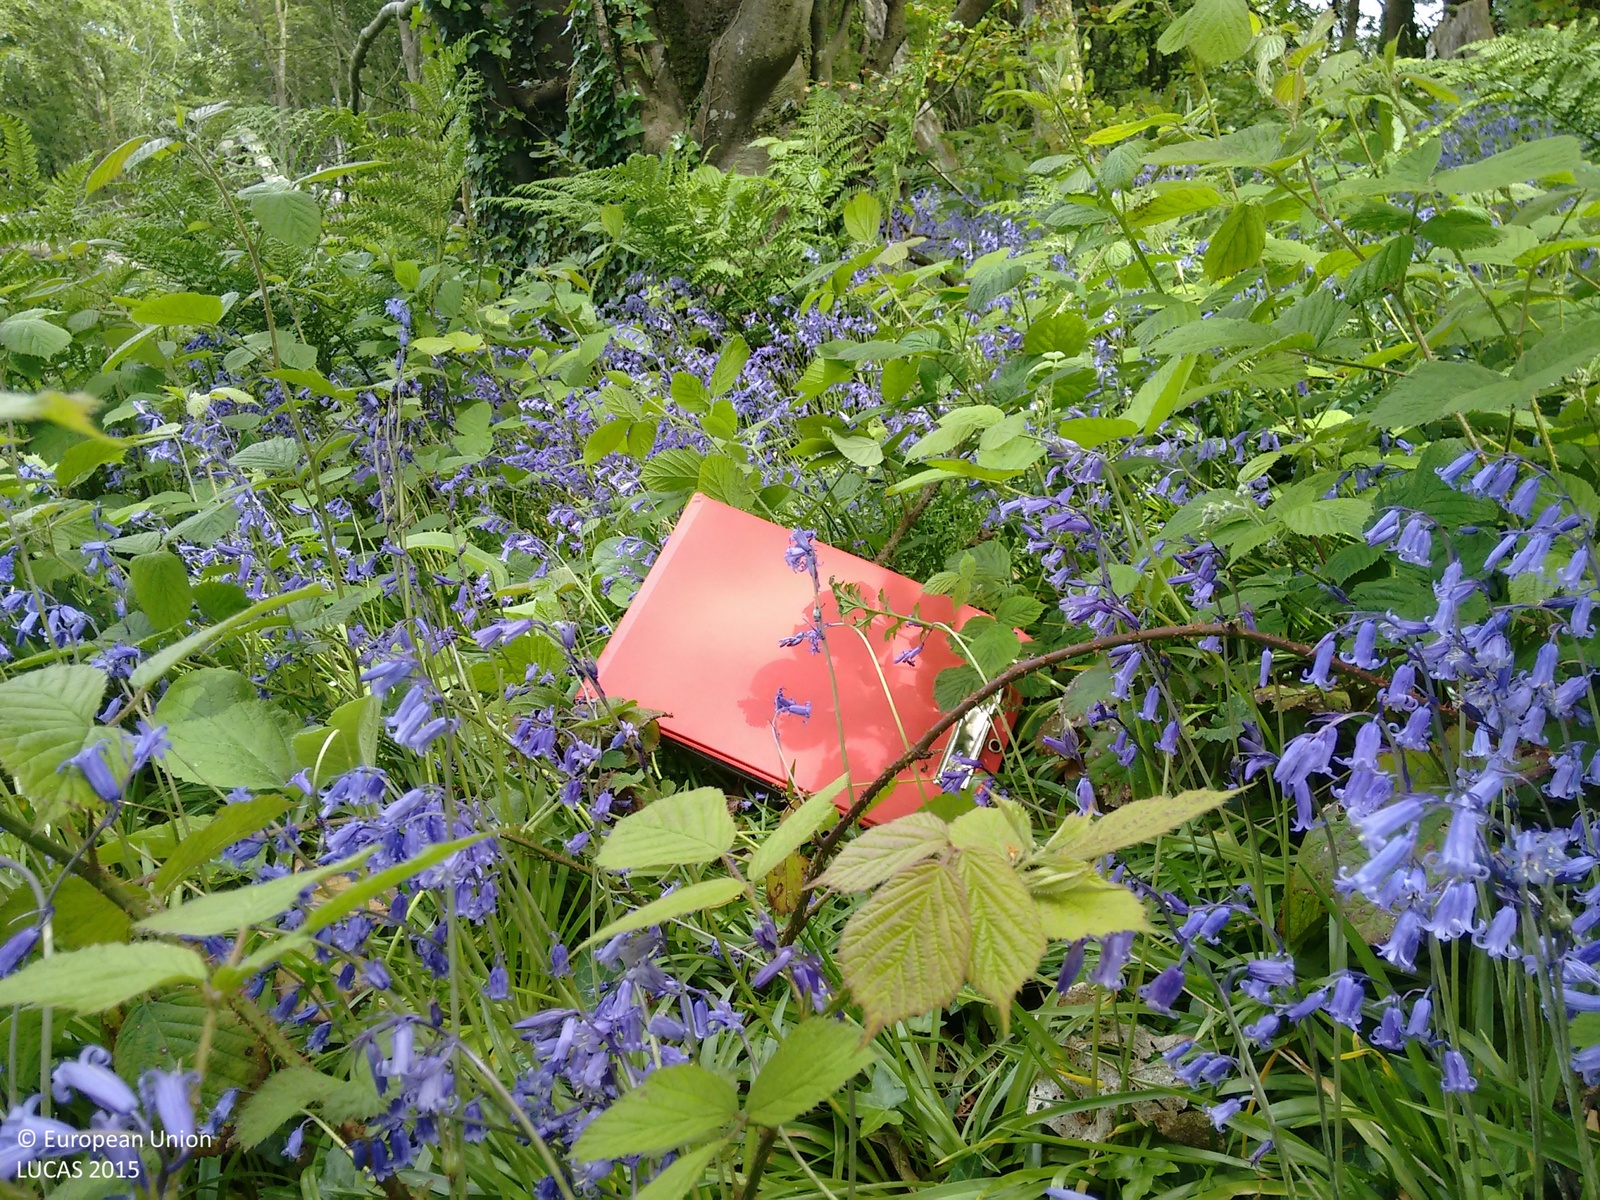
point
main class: Woodland
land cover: Broadleaved woodland
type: mesophytic deciduous forest
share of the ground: > 75 %
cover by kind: broadleaved forest trees 90 %, shrubs 10 %
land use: Semi-natural and natural areas not in use
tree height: > 5 m
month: June
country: IE
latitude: 51.8920
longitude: -8.0959
